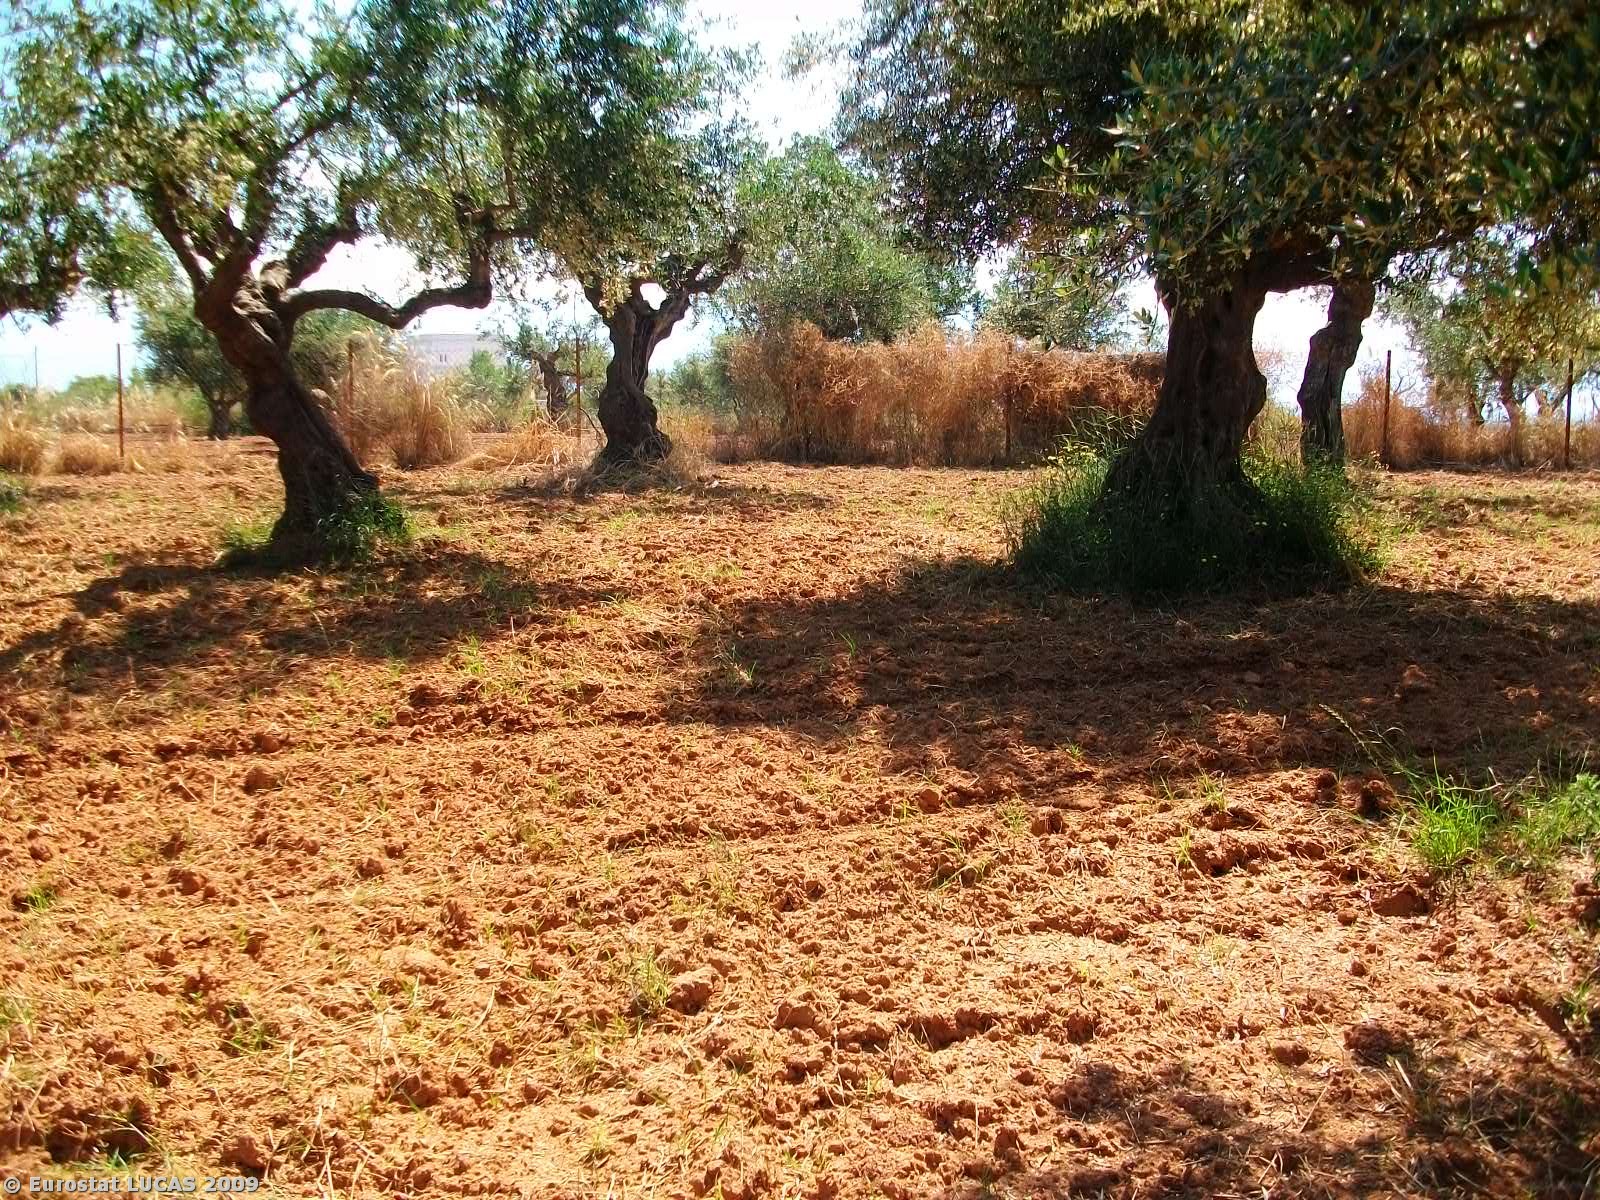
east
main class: Cropland
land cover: Olive groves
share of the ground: 25 - 50 %
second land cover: Bare land
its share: > 75 %
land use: Agriculture (excluding fallow land and kitchen gardens)
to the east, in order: Olive groves; Bare land; Fences; Grass margins; Olive groves; Other citrus fruit; Fences; Artificial constructions in urban areas; Fences; Olive groves; Grassland with sparse tree/shrub cover
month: May
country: GR
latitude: 37.0225
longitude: 21.9911
